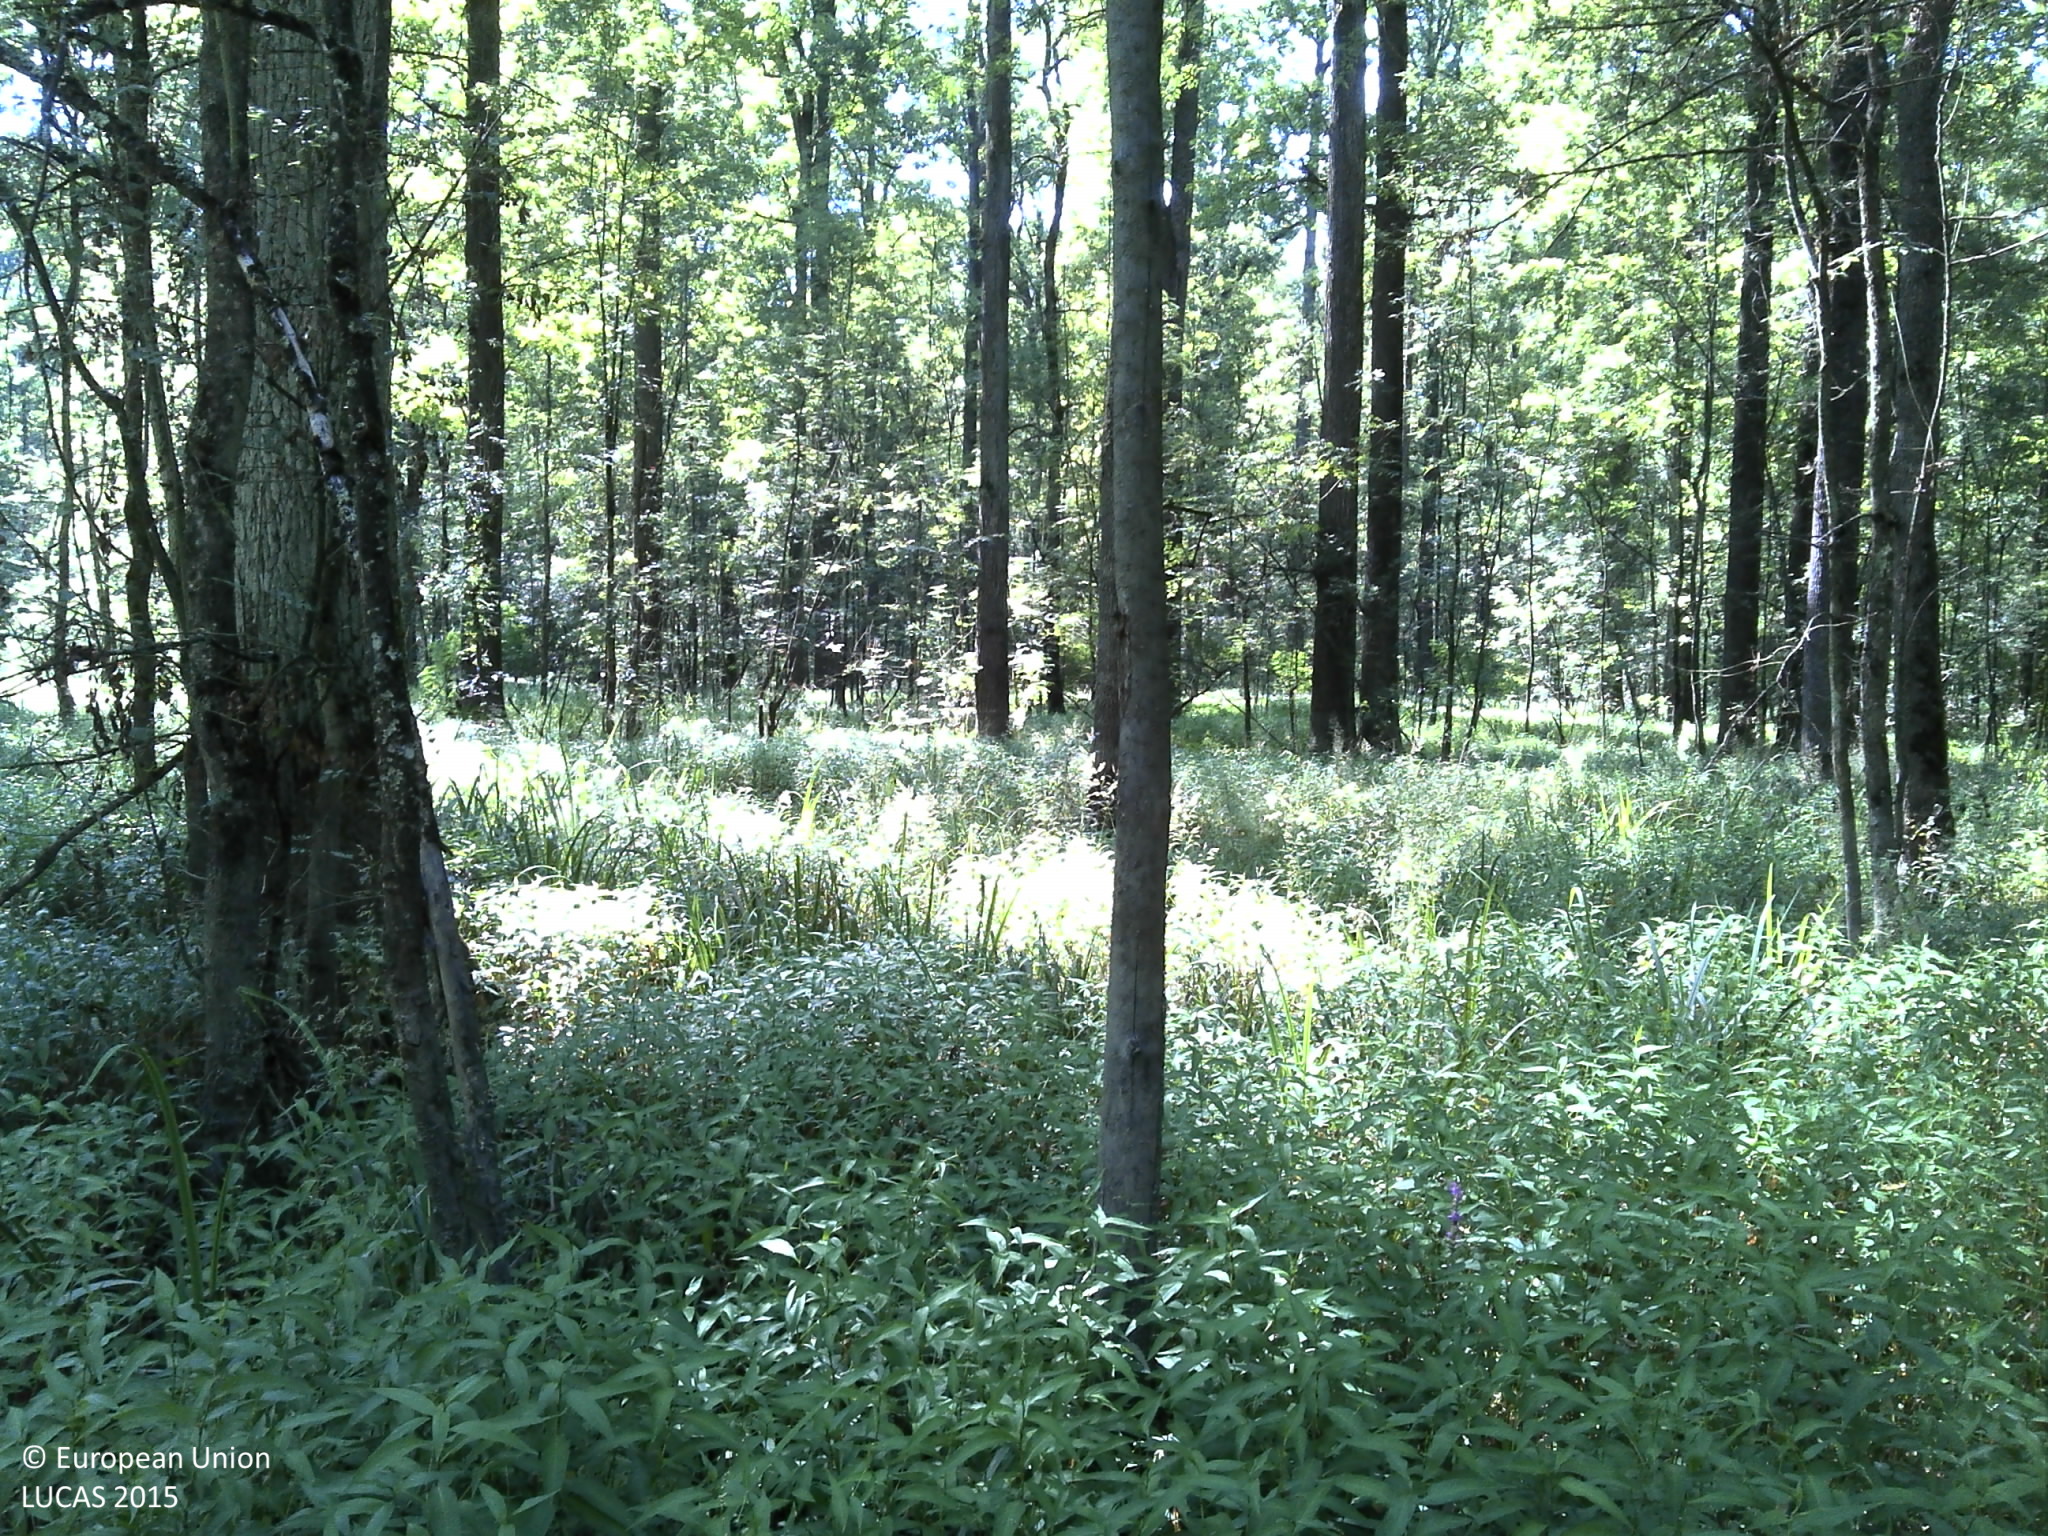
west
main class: Woodland
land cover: Broadleaved woodland
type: acidophilous oak and oak-birch forest
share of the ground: > 75 %
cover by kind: broadleaved forest trees 80 %, lichens and mosses 20 %
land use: Forestry
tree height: > 5 m
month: July
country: HR
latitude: 45.4127
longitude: 16.7838
